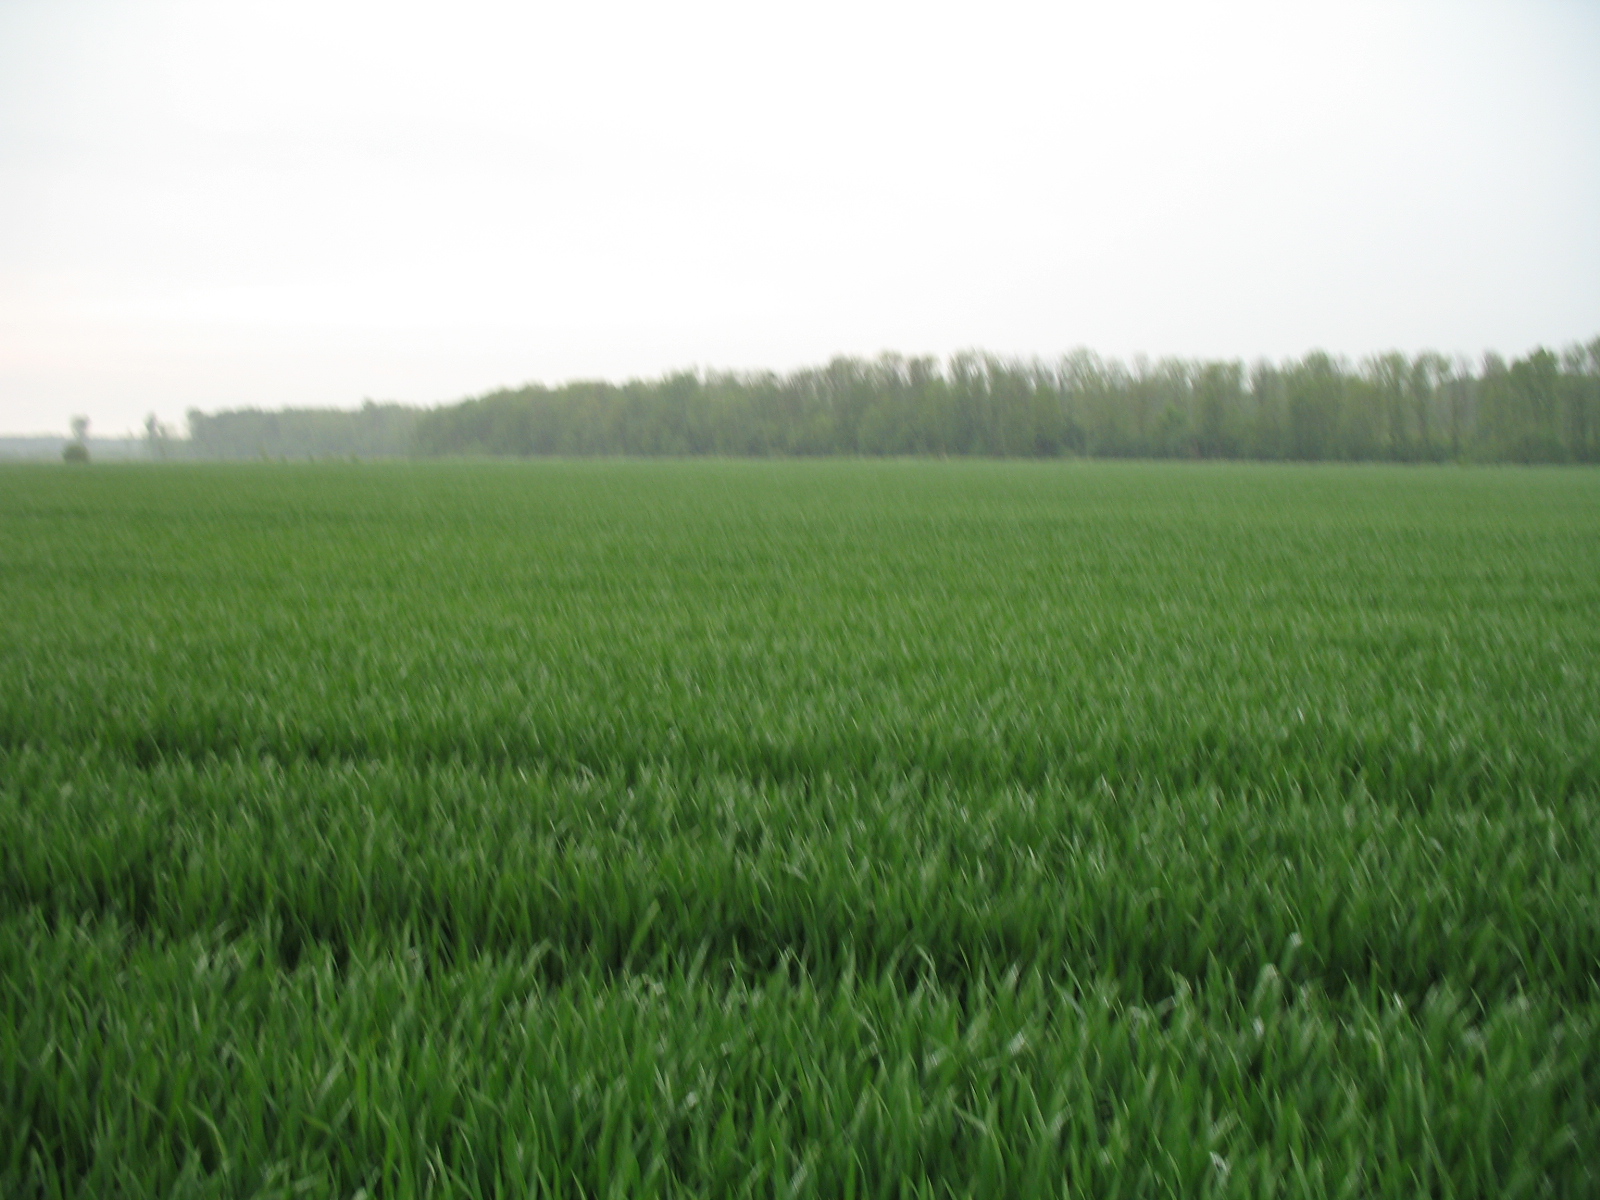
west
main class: Cropland
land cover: Common wheat
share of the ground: > 75 %
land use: Agriculture (excluding fallow land and kitchen gardens)
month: May
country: LV
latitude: 56.7308
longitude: 23.4930
